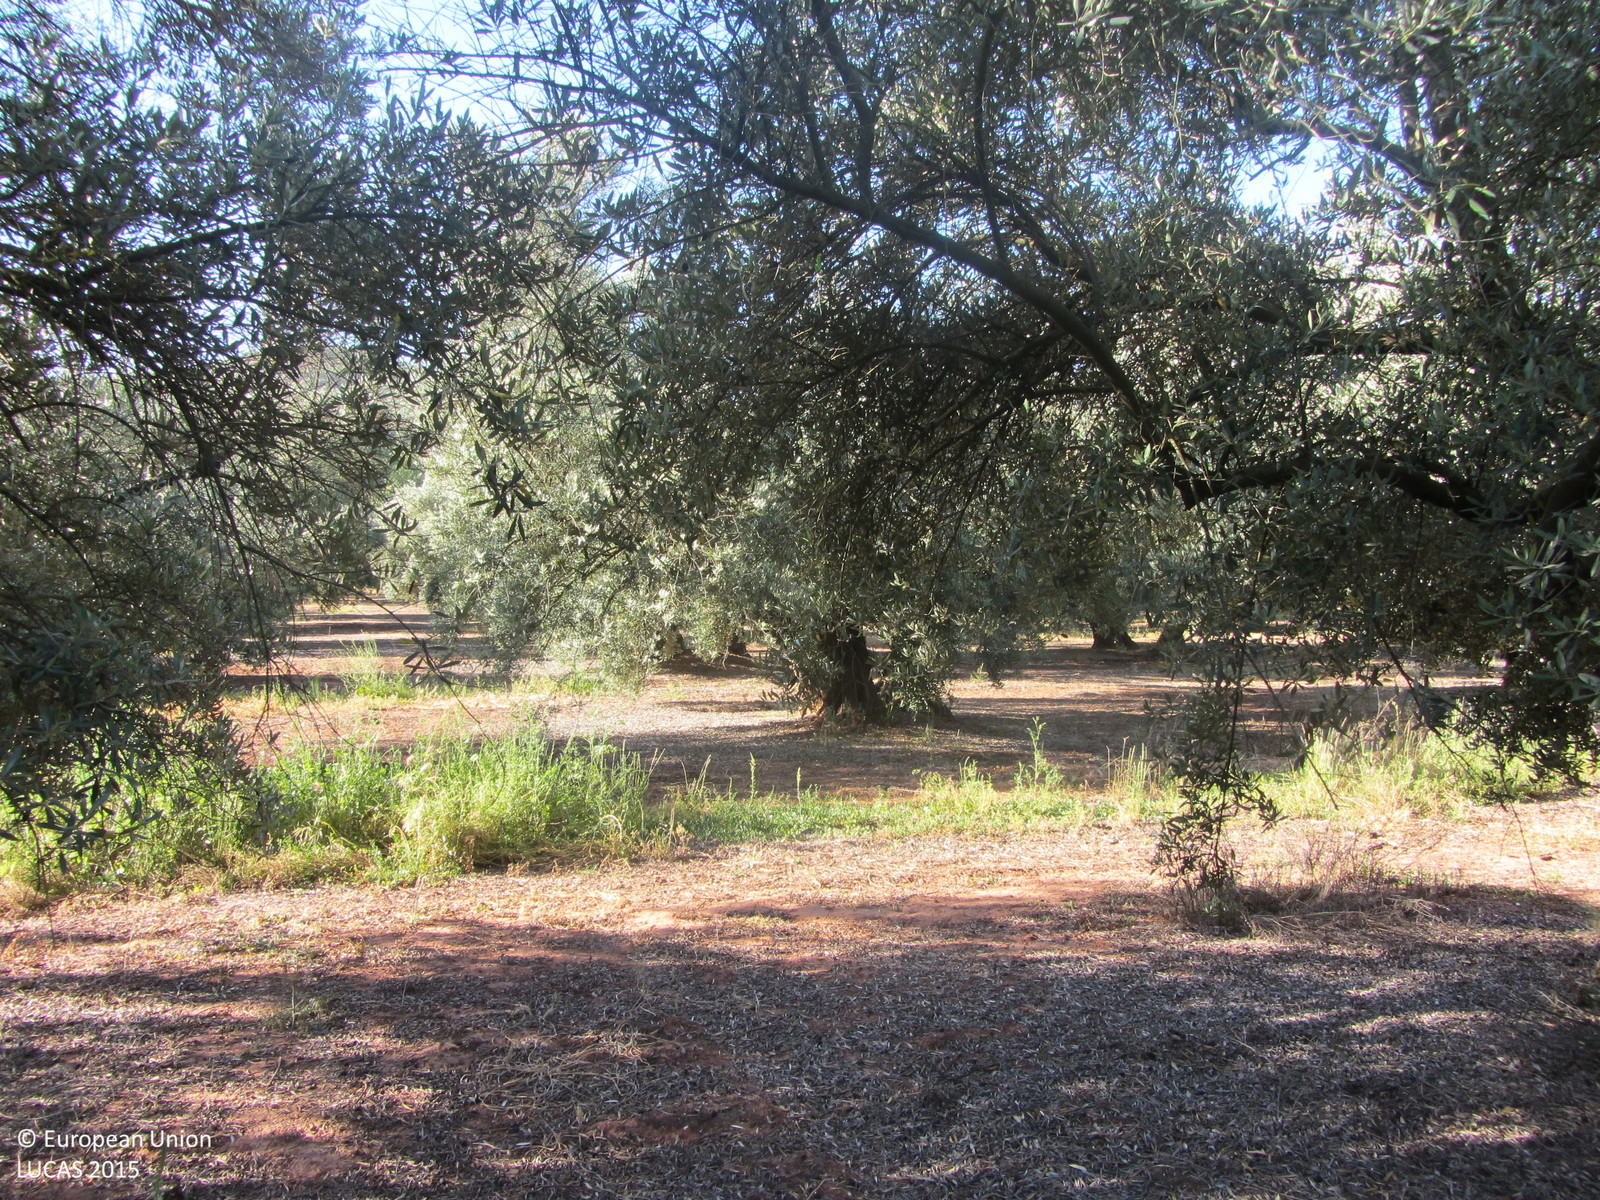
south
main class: Cropland
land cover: Olive groves
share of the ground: 50 - 75 %
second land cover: Spontaneously vegetated surfaces
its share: 10 - 25 %
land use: Agriculture (excluding fallow land and kitchen gardens)
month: May
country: ES
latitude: 38.1737
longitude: -3.1157
